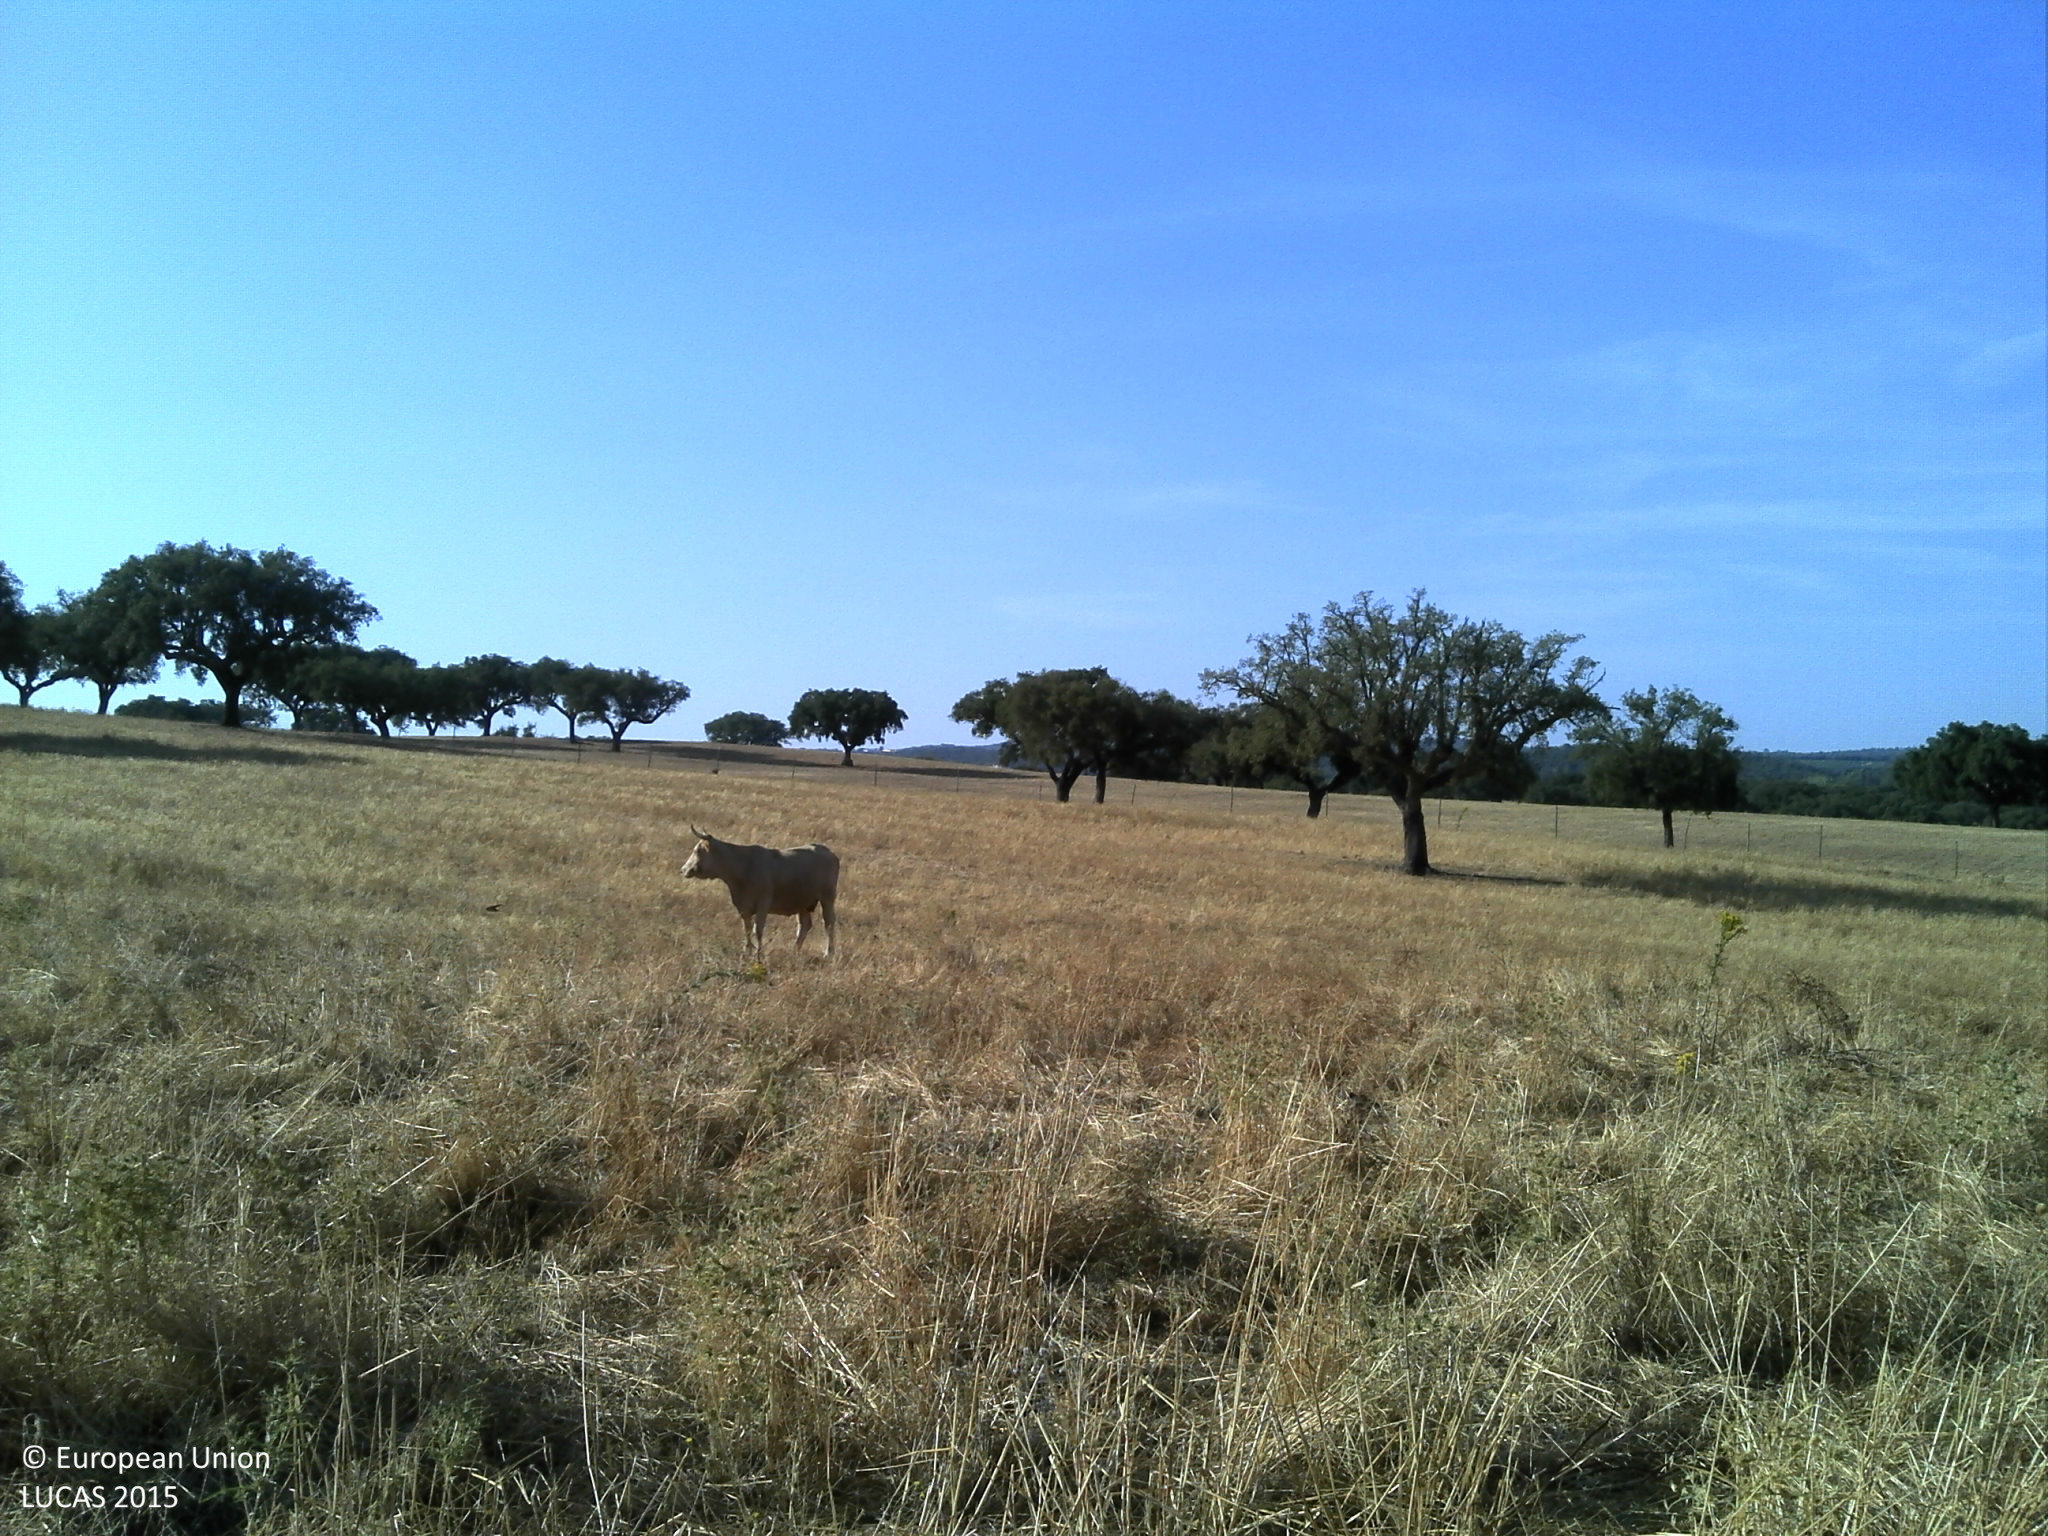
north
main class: Grassland
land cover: Grassland without tree/shrub cover
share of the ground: 50 - 75 %
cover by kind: herbaceous plants 75 %, unconsolidated bare surface 25 %
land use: Agriculture (excluding fallow land and kitchen gardens)
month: July
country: PT
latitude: 38.7657
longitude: -7.5393
